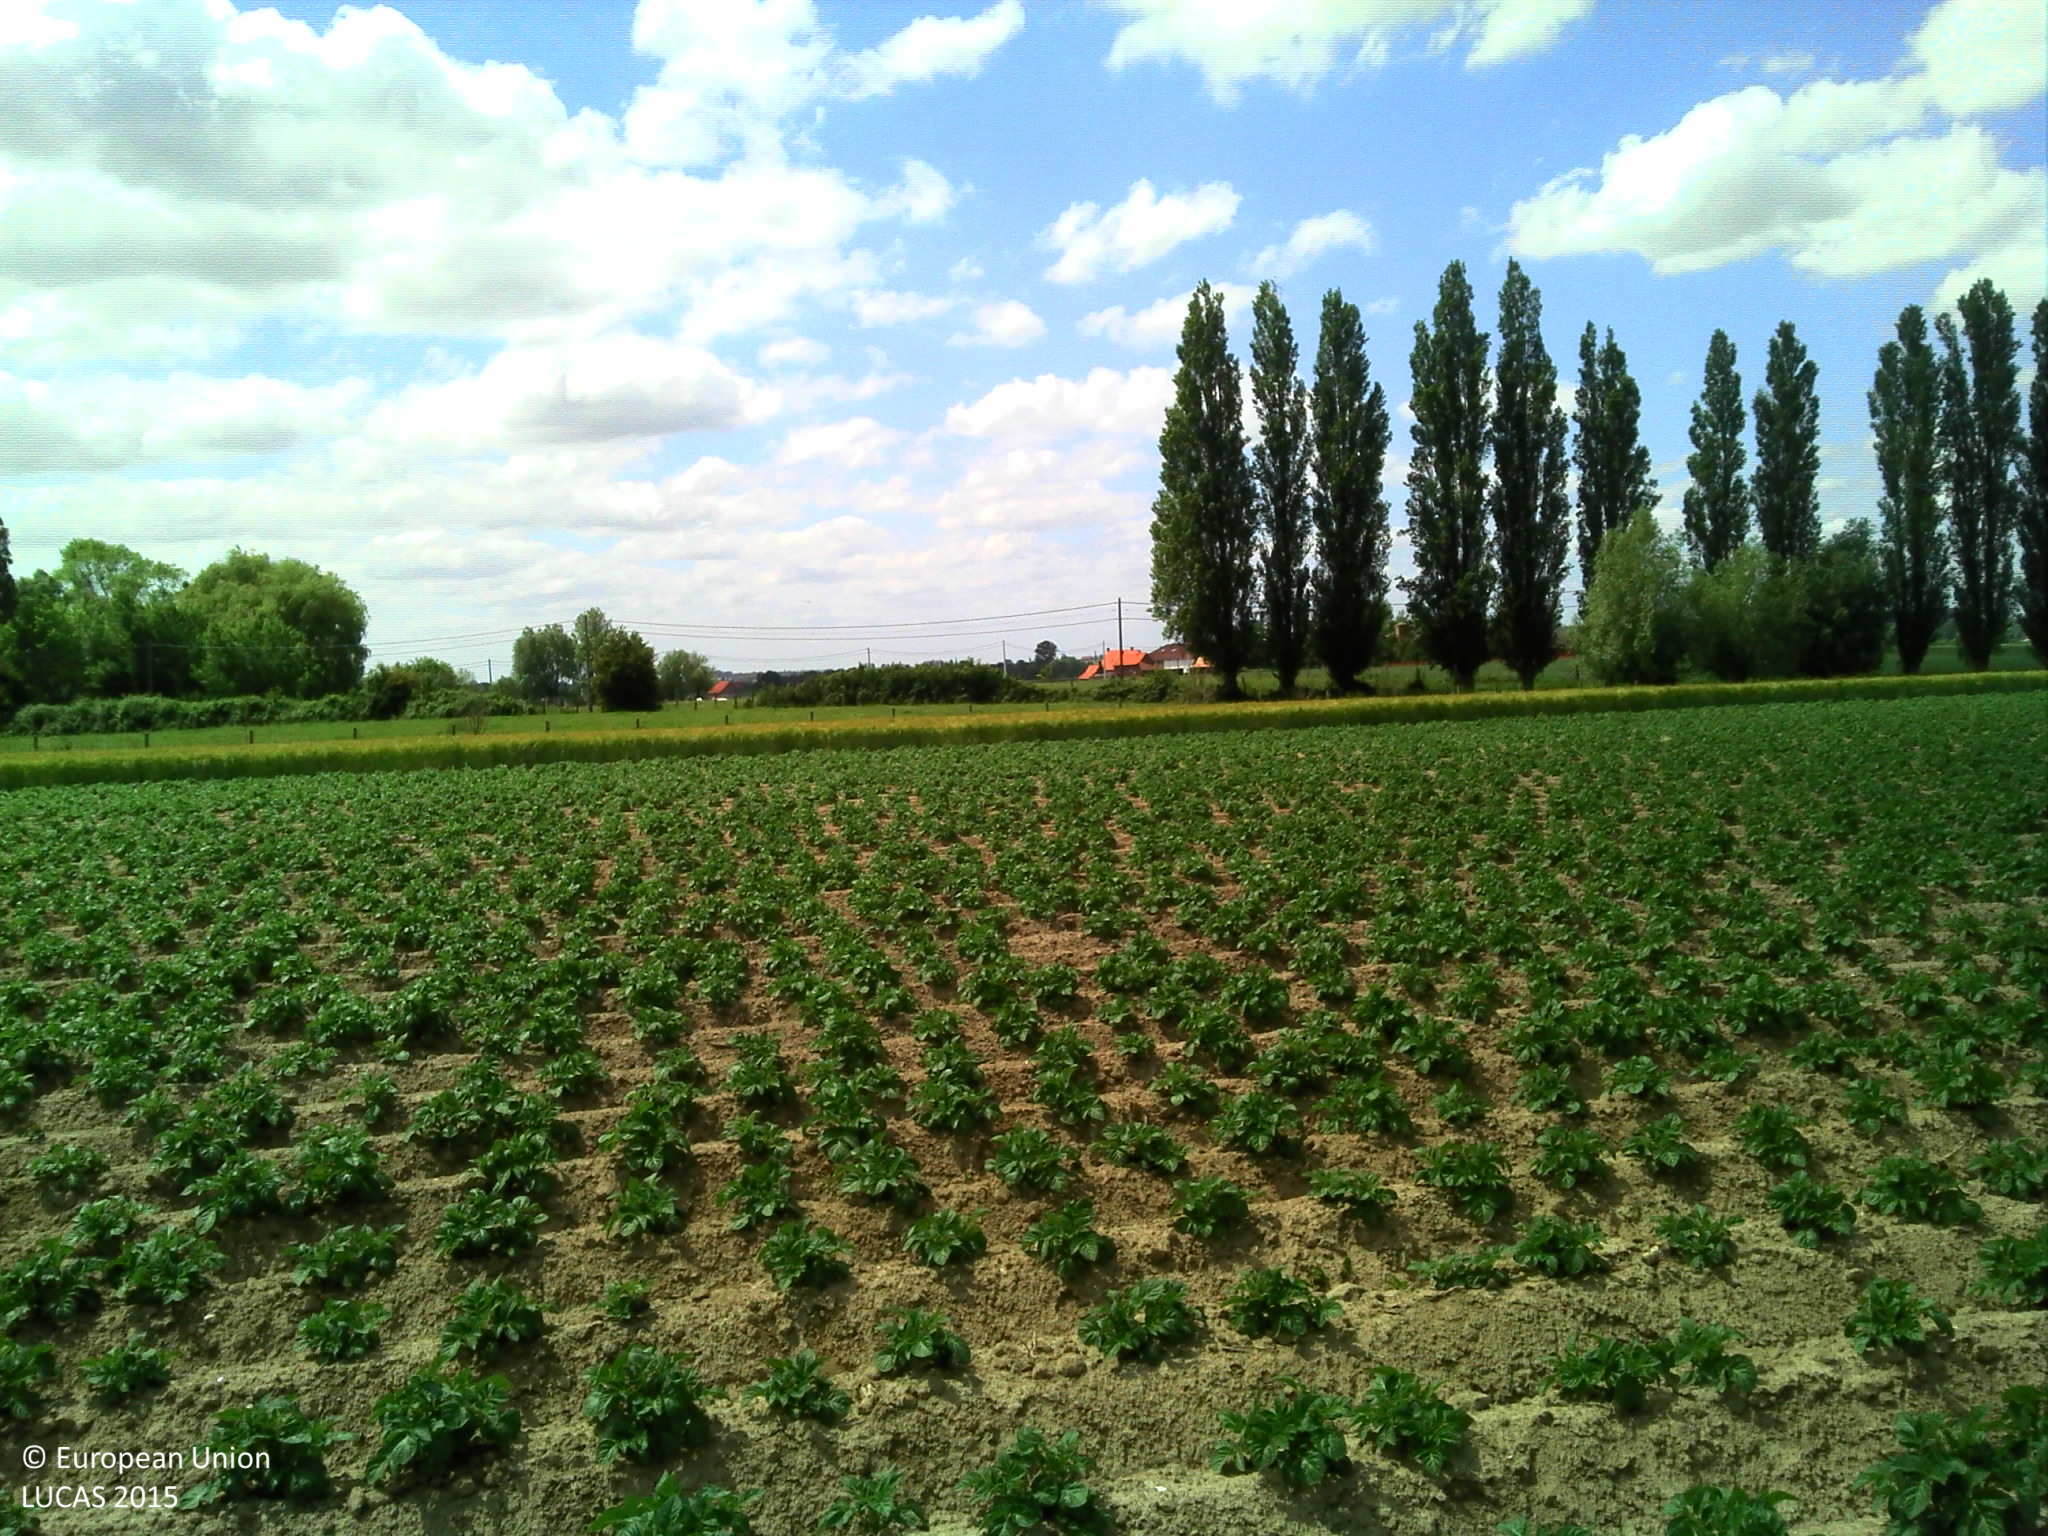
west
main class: Cropland
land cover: Potatoes
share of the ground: 10 - 25 %
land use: Agriculture (excluding fallow land and kitchen gardens)
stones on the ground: < 10 %
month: June
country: BE
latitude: 50.8369
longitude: 2.7324
